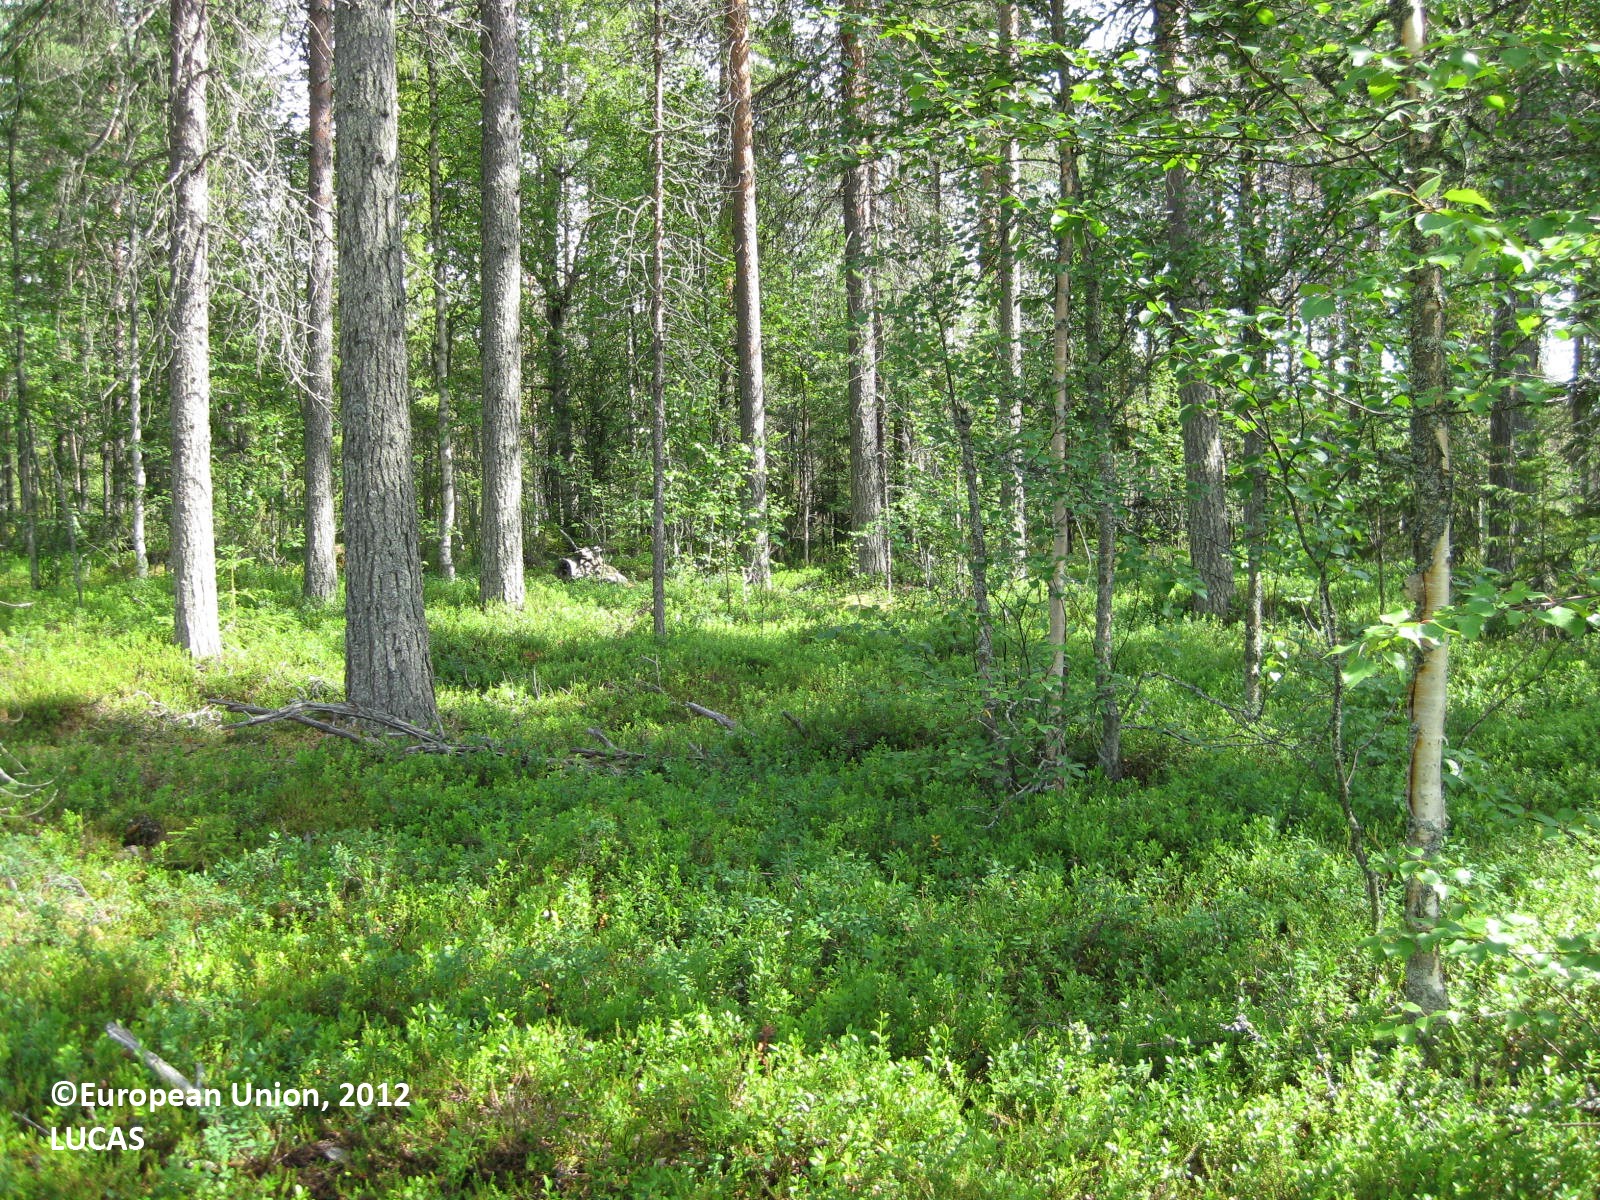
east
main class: Woodland
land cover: Pine dominated mixed woodland
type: boreal forest
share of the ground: 50 - 75 %
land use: Forestry
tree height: > 5 m
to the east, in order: Pine dominated mixed woodland; Tracks; Pine dominated mixed woodland; Pine dominated coniferous woodland; Other coniferous woodland; Pine dominated mixed woodland; Broadleaved woodland; Pine dominated mixed woodland
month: July
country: FI
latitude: 65.7023
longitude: 29.3332
